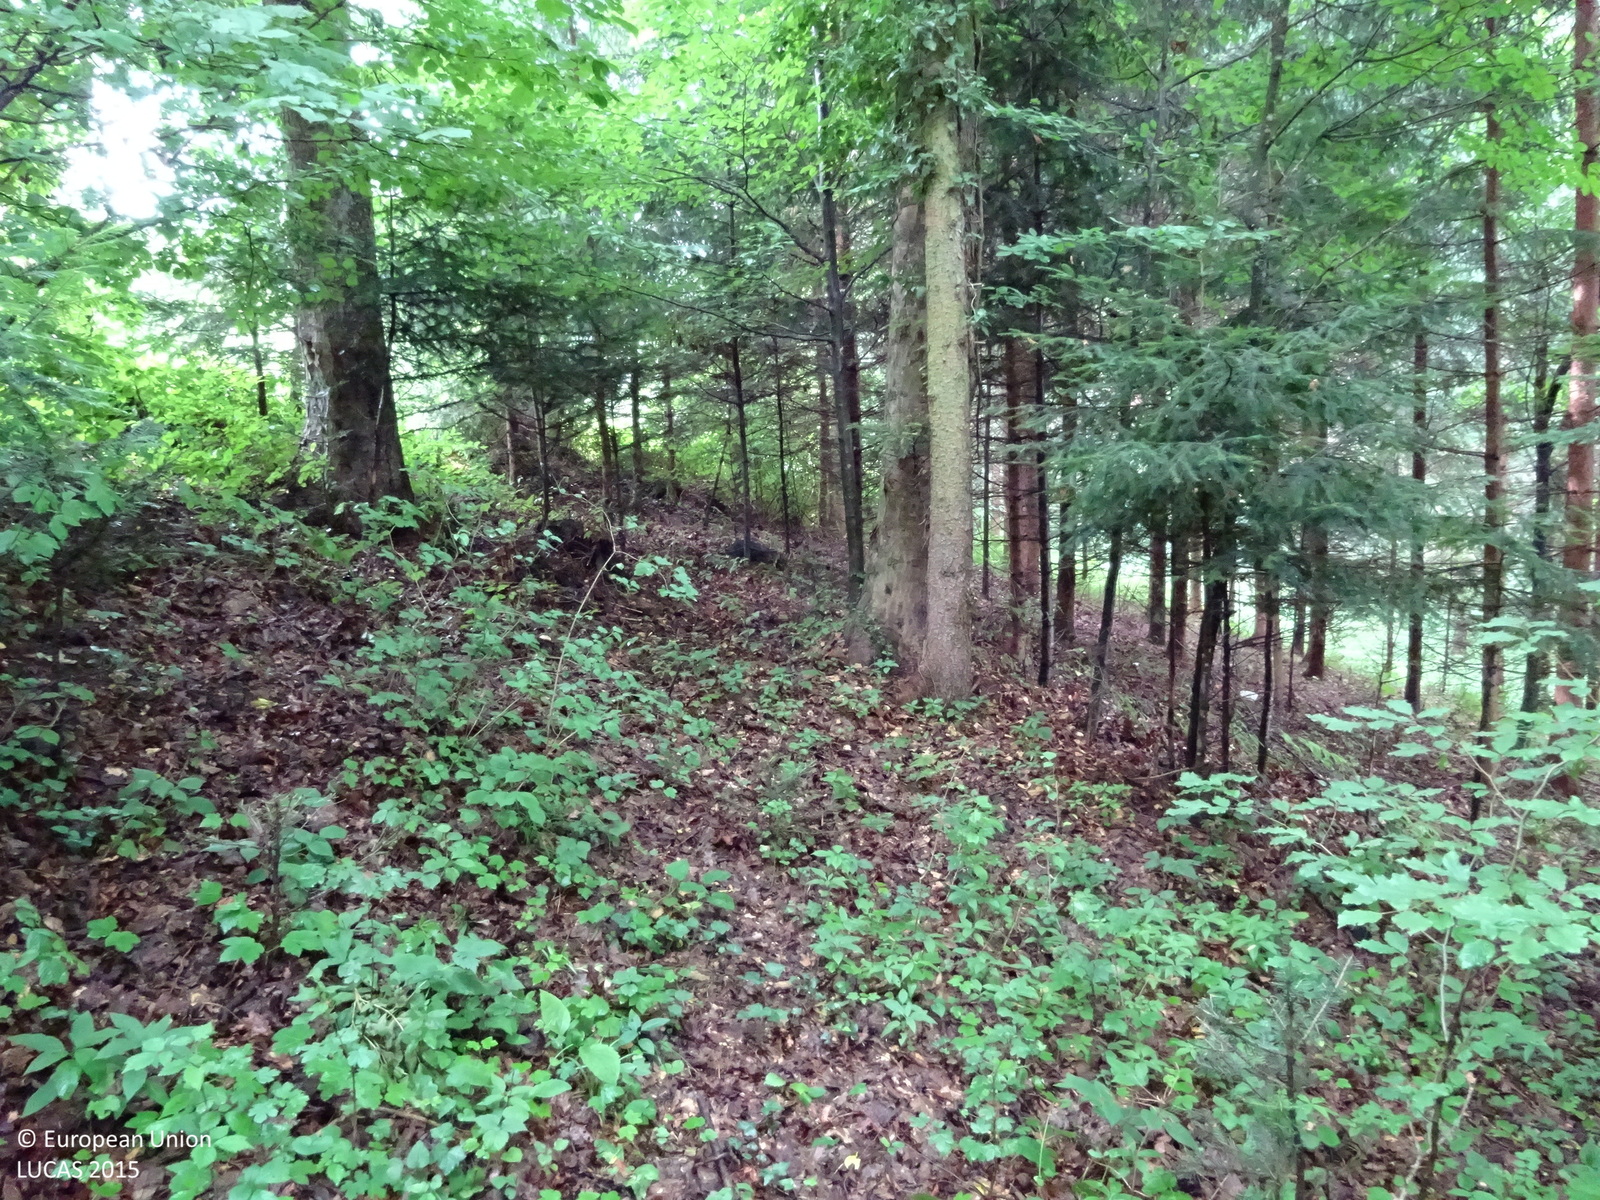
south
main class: Woodland
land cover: Broadleaved woodland
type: mountainous beech forest
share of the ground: > 75 %
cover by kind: broadleaved forest trees 80 %, coniferous forest trees 10 %, herbaceous plants 10 %
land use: Forestry
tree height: > 5 m
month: June
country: AT
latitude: 46.6662
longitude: 15.3968
